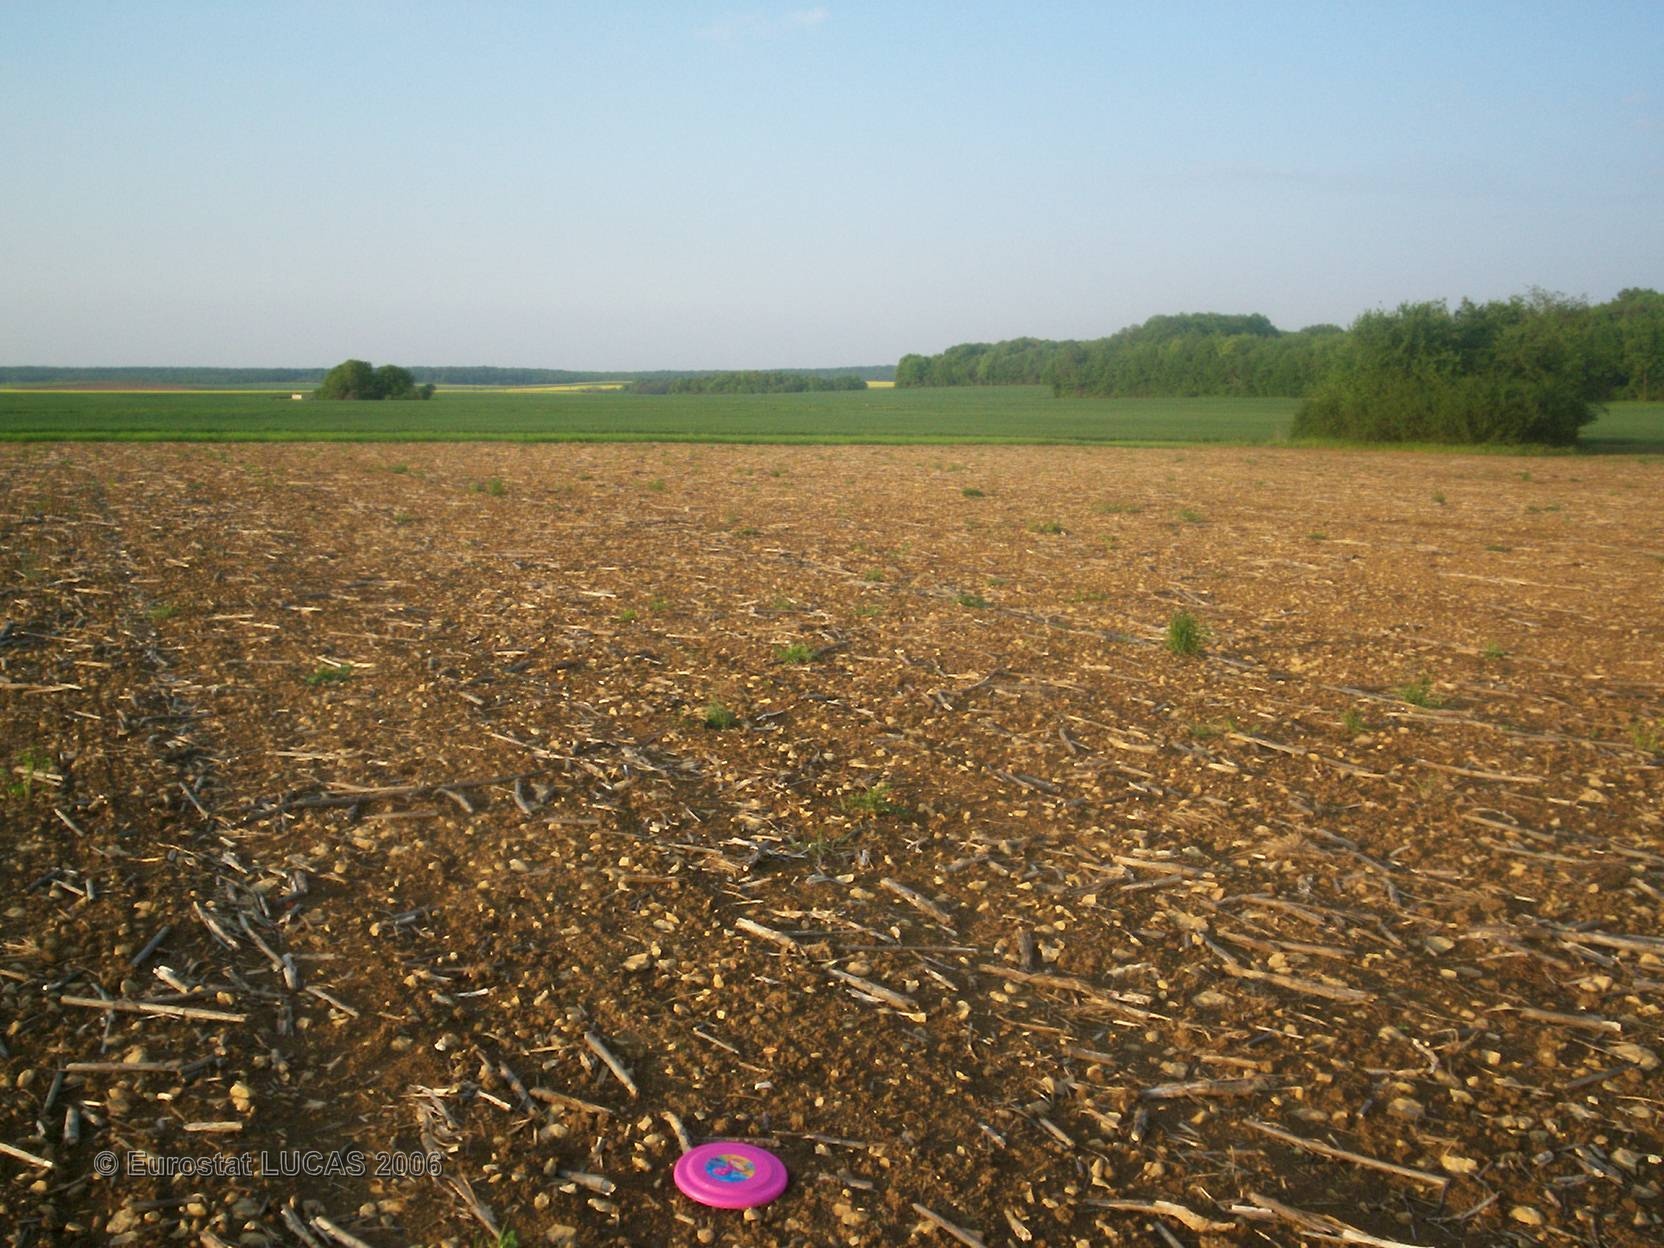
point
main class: Cropland
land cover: Other leguminous and mixtures for fodder
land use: Agriculture (excluding fallow land and kitchen gardens)
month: May
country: FR
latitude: 48.3931
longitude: 4.8798
